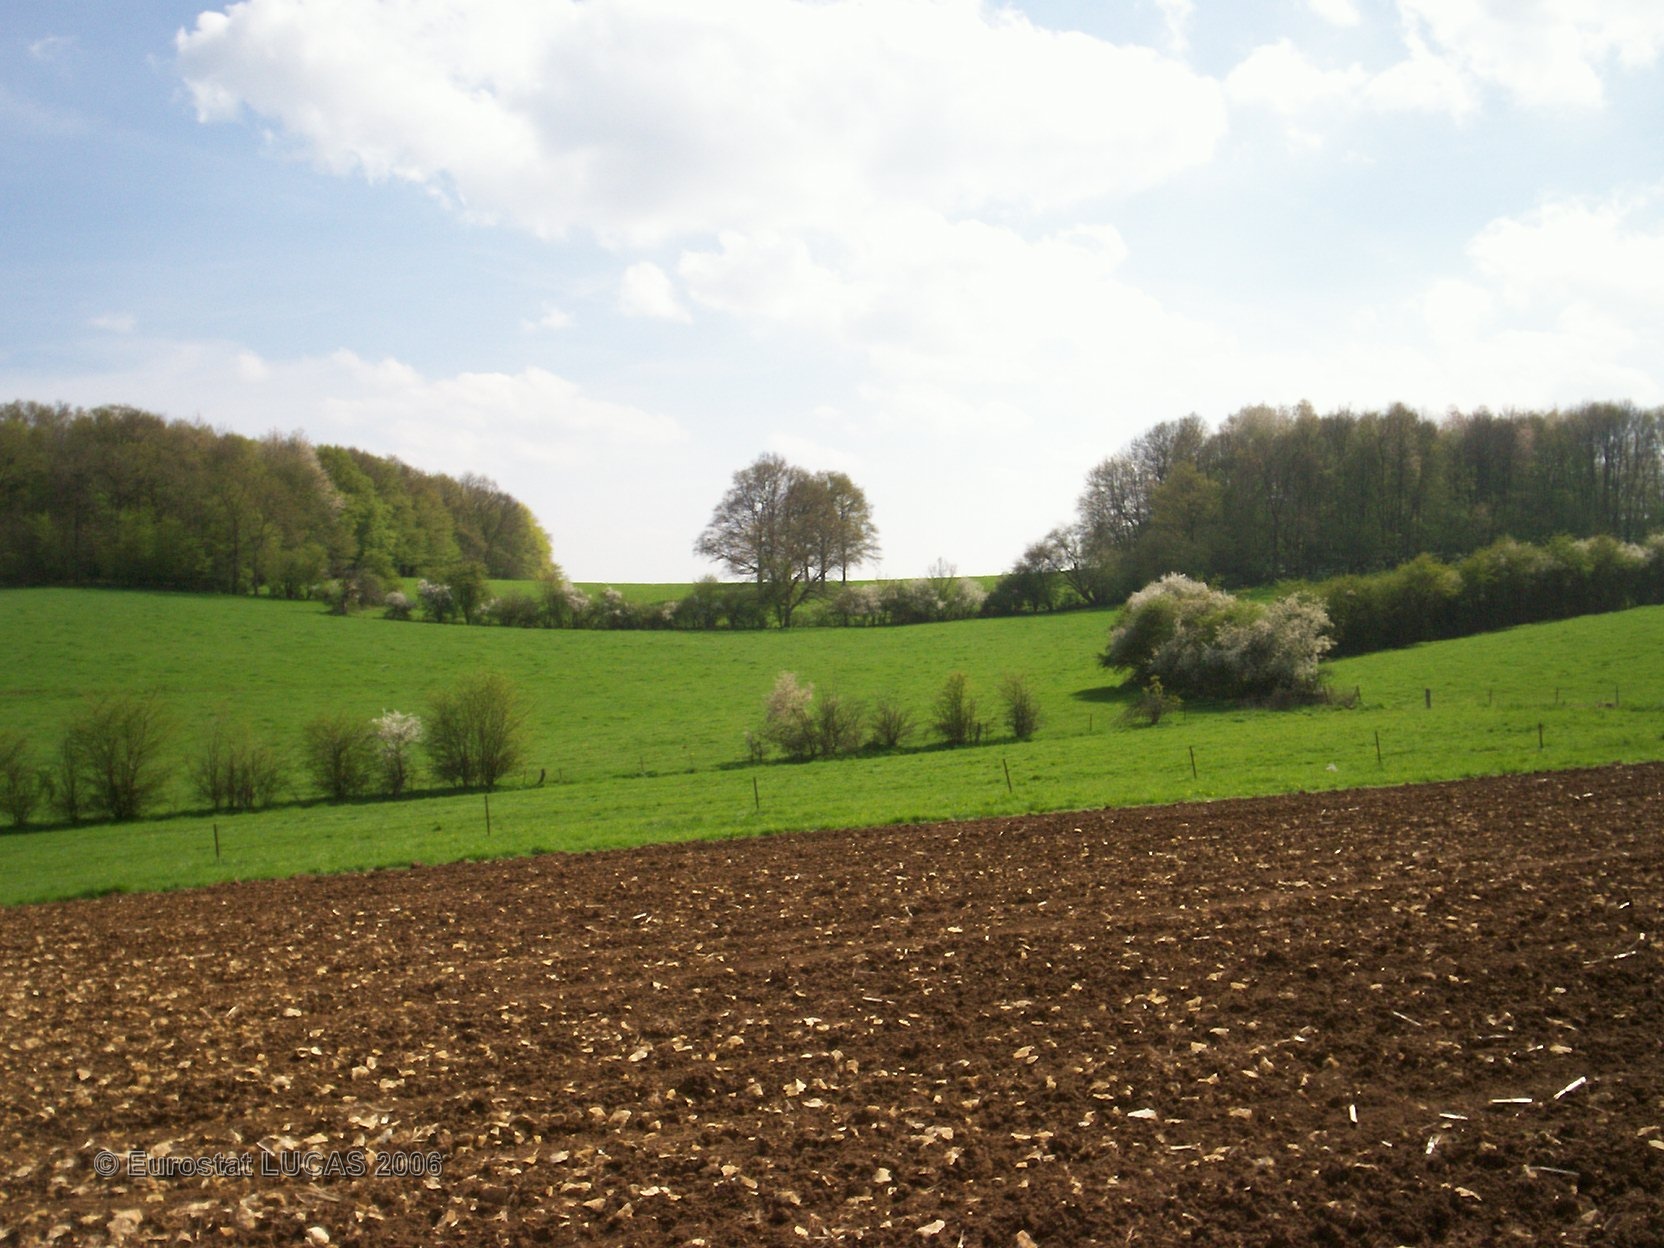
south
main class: Cropland
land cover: Maize
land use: Agriculture (excluding fallow land and kitchen gardens)
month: May
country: FR
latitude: 49.8245
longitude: 4.2824
